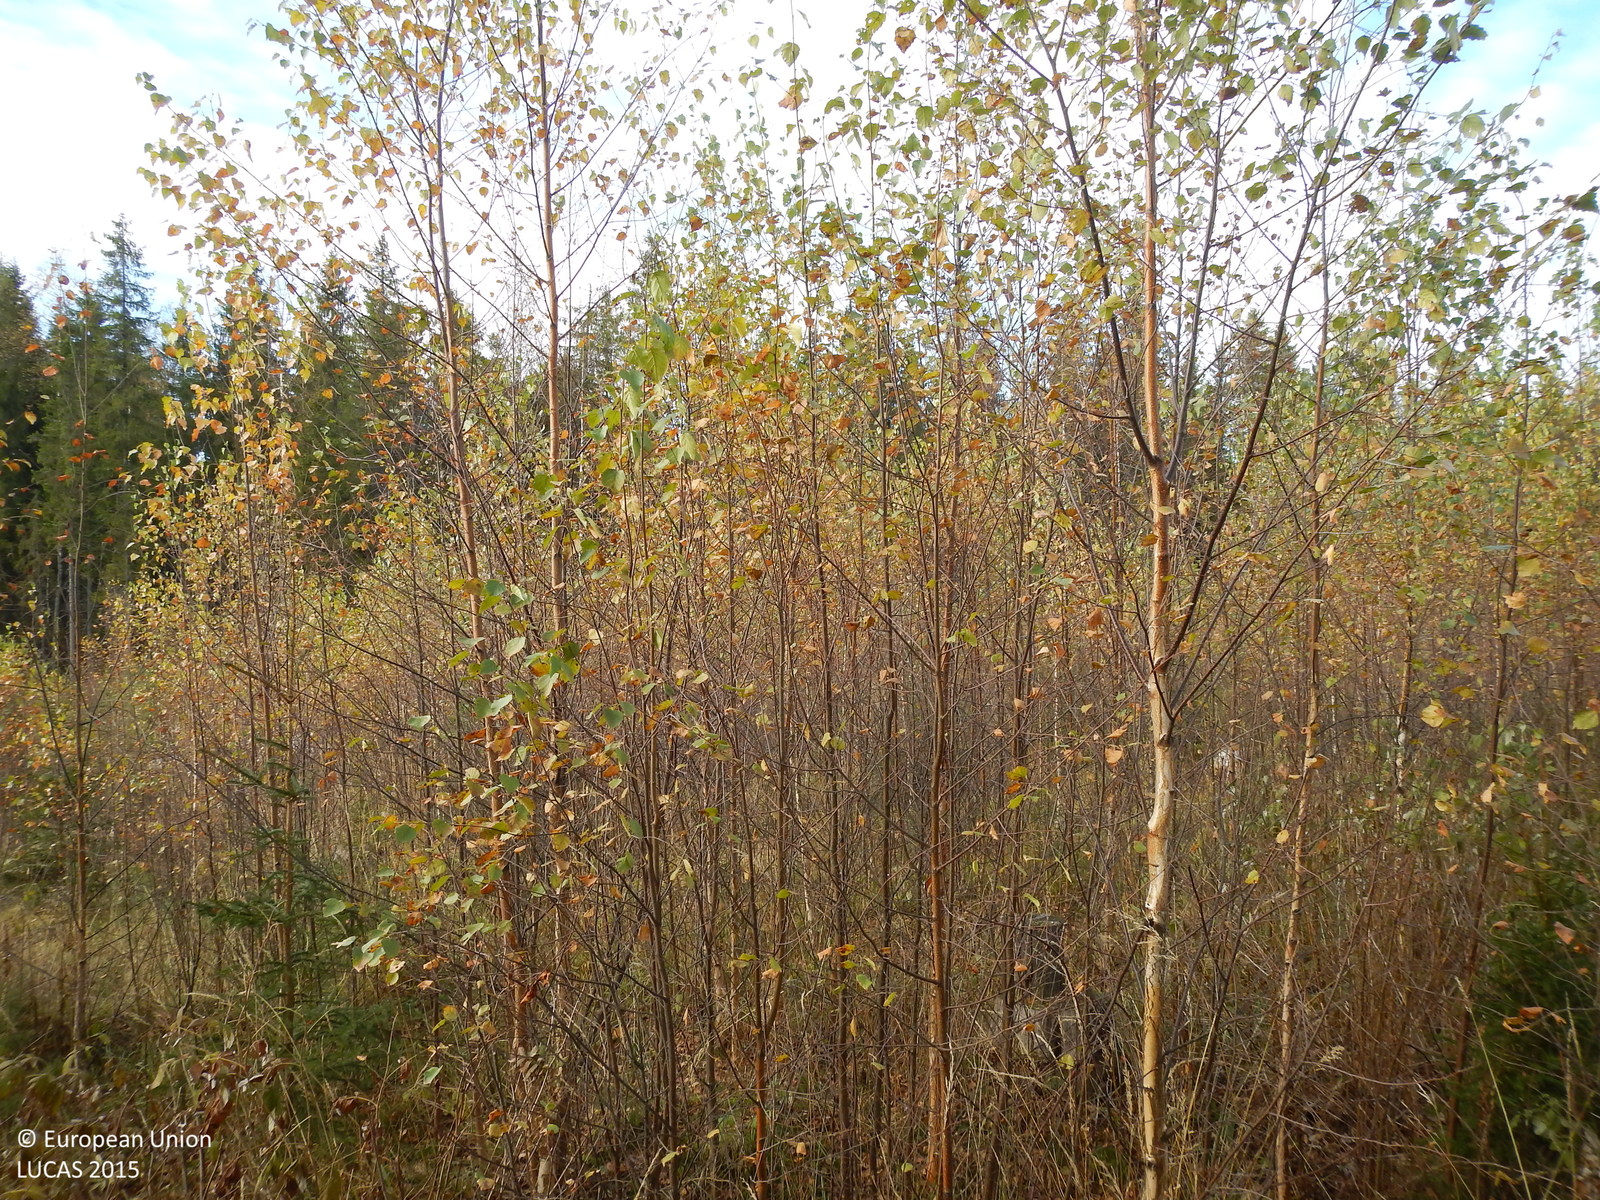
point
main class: Woodland
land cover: Broadleaved woodland
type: boreal forest
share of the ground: > 75 %
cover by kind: broadleaved forest trees 90 %, herbaceous plants 10 %
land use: Forestry
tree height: < 5 m
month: October
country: FI
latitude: 61.8495
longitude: 25.9175
